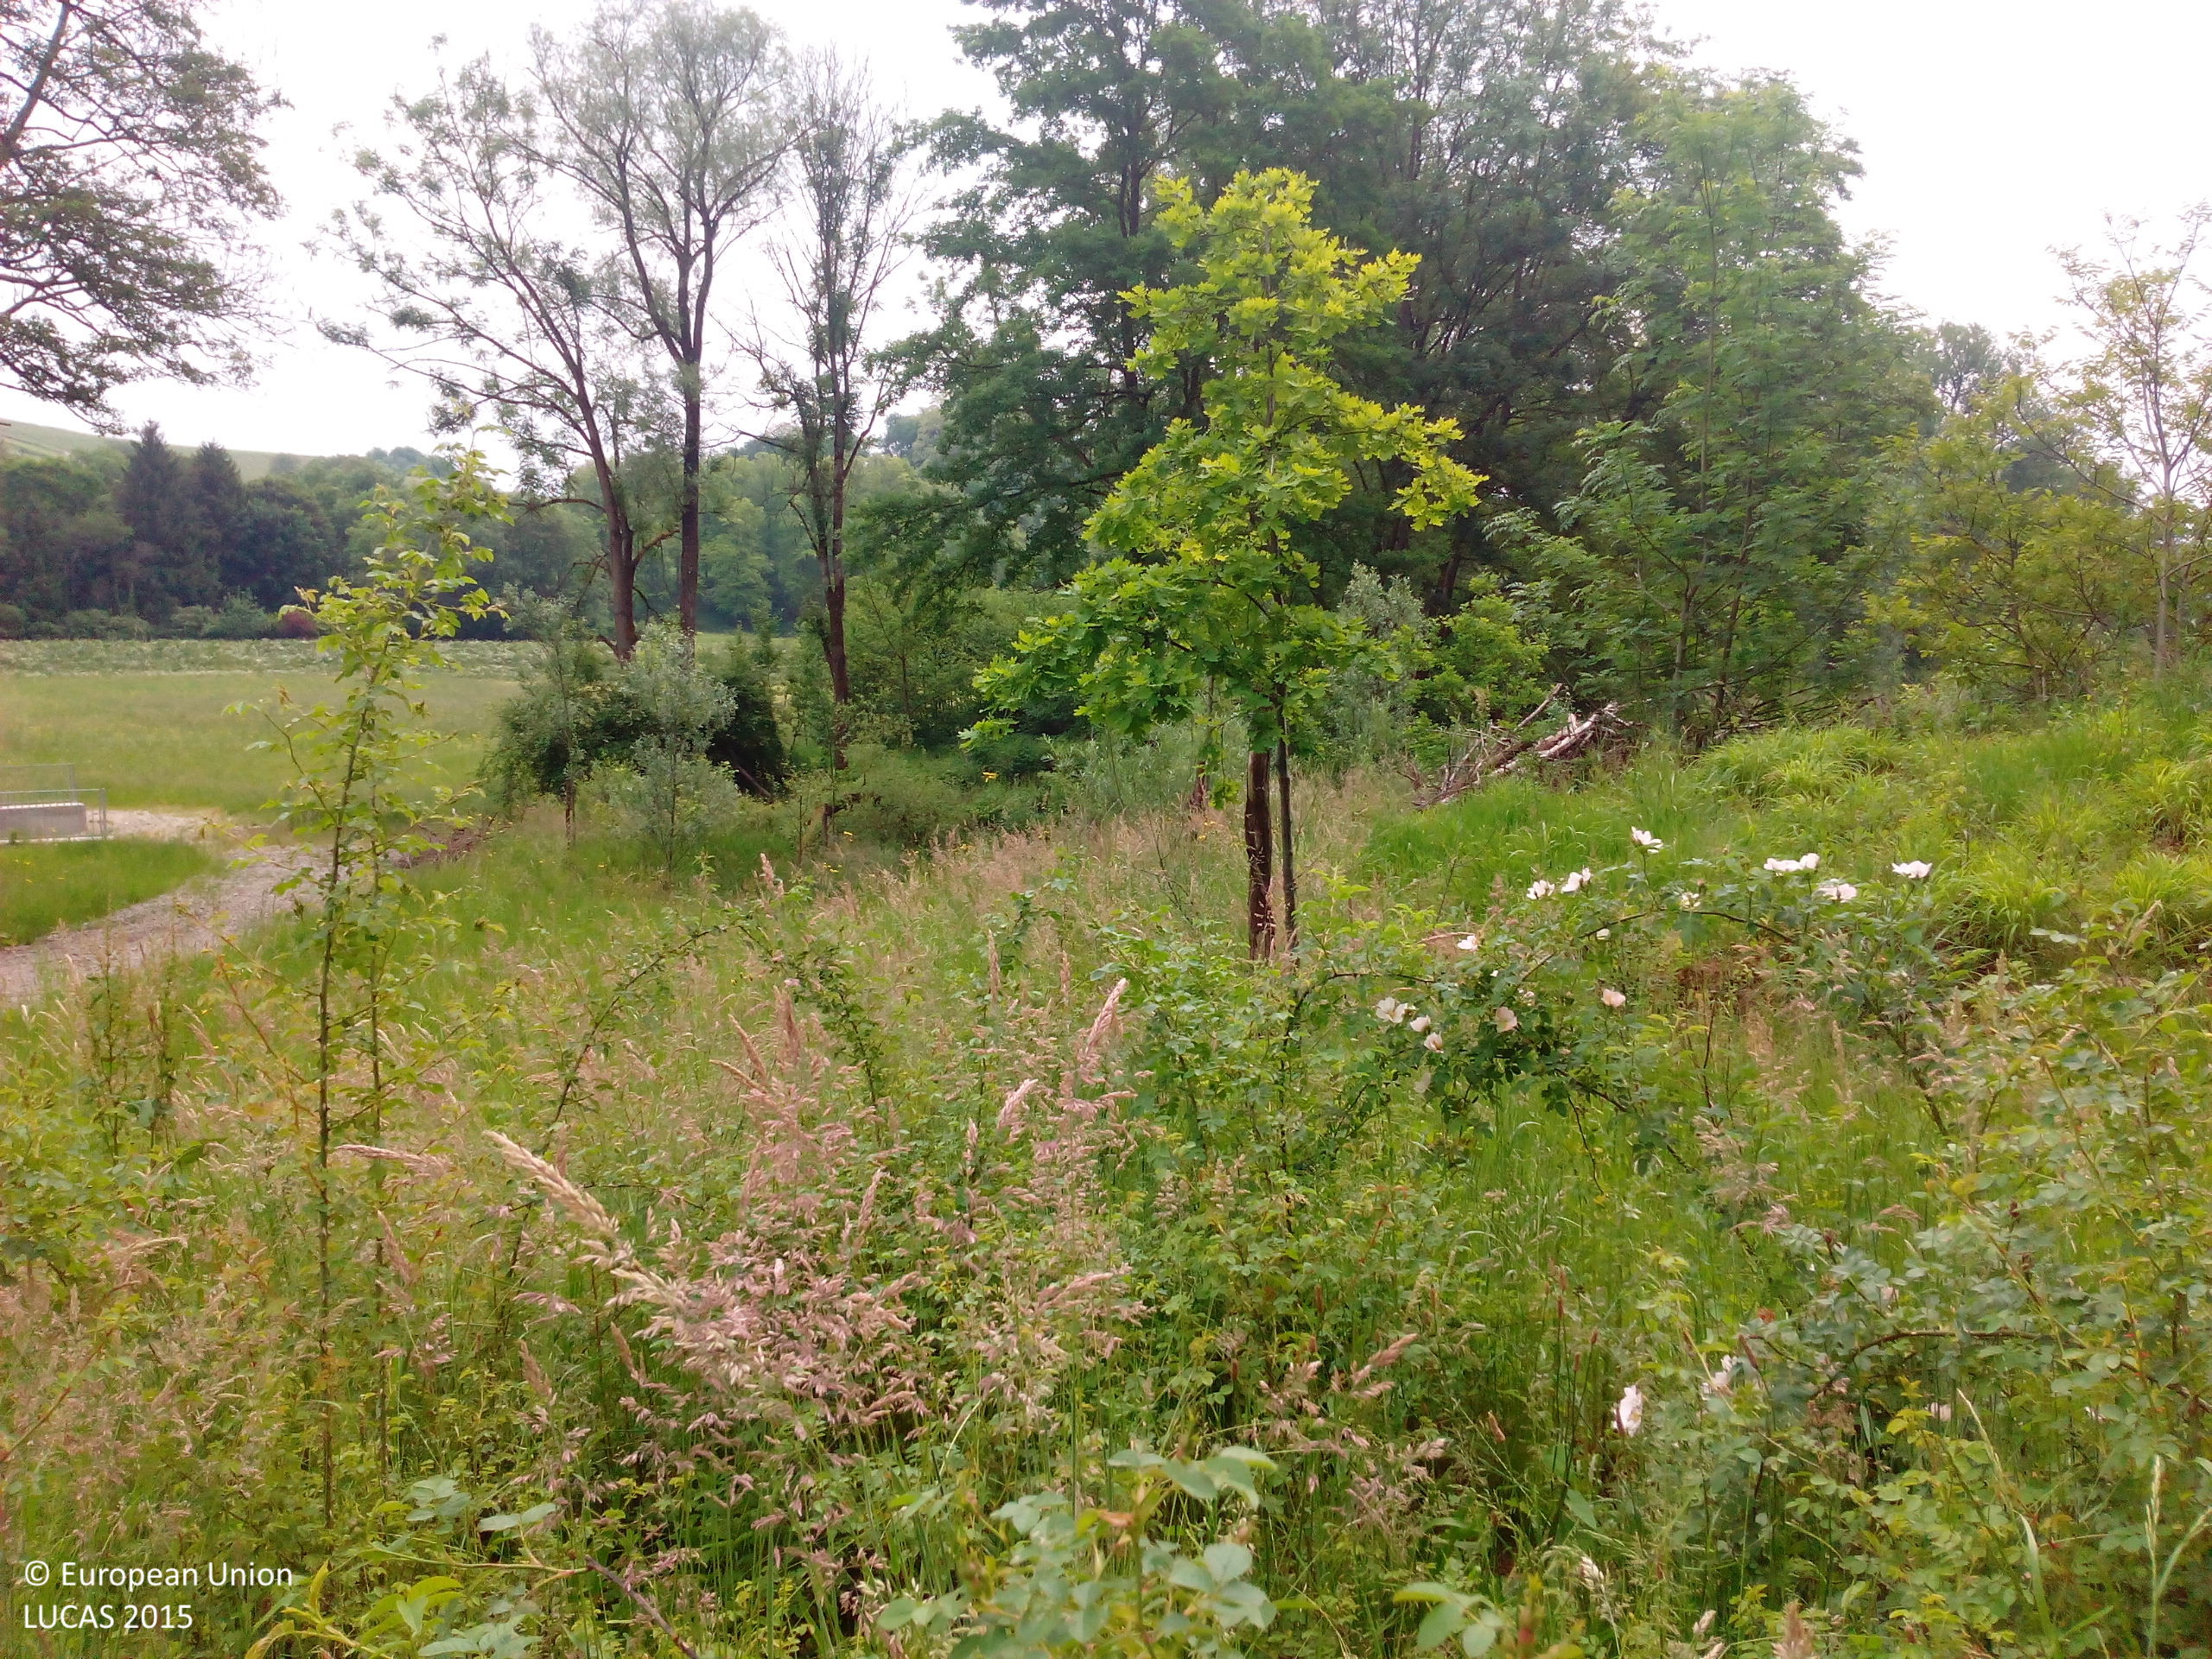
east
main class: Grassland
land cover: Grassland with sparse tree/shrub cover
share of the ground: > 75 %
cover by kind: herbaceous plants 90 %, broadleaved forest trees 5 %, shrubs 5 %
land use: Semi-natural and natural areas not in use
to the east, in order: Grassland with sparse tree/shrub cover; Broadleaved woodland; Inland fresh running water; Broadleaved woodland; Grass margins; Maize; Grass margins; Tracks; Grassland without tree/shrub cover; Paved roads, cycling and walking lanes; Grassland without tree/shrub cover; Paved roads, cycling and walking lanes
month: May
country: DE
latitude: 47.7470
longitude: 7.5873
